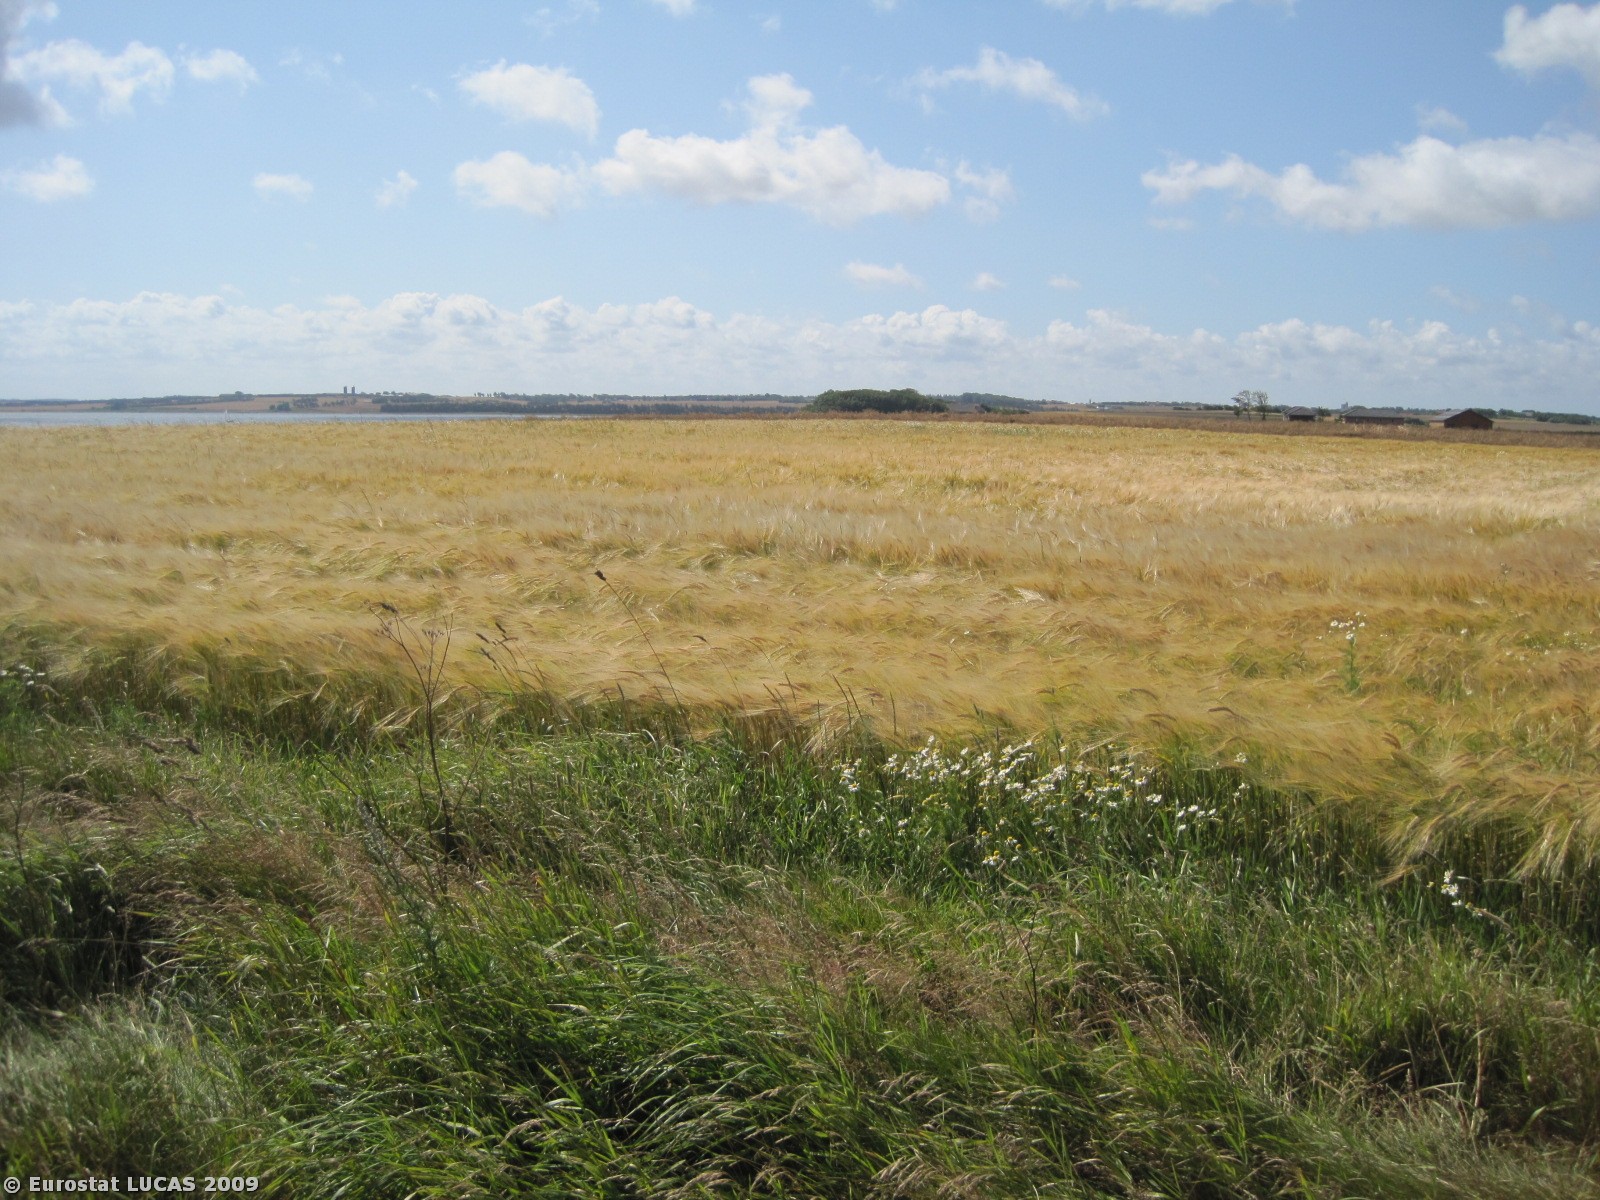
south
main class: Grassland
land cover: Grassland without tree/shrub cover
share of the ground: > 75 %
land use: Agriculture (excluding fallow land and kitchen gardens)
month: July
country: DK
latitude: 56.7362
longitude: 8.4817
